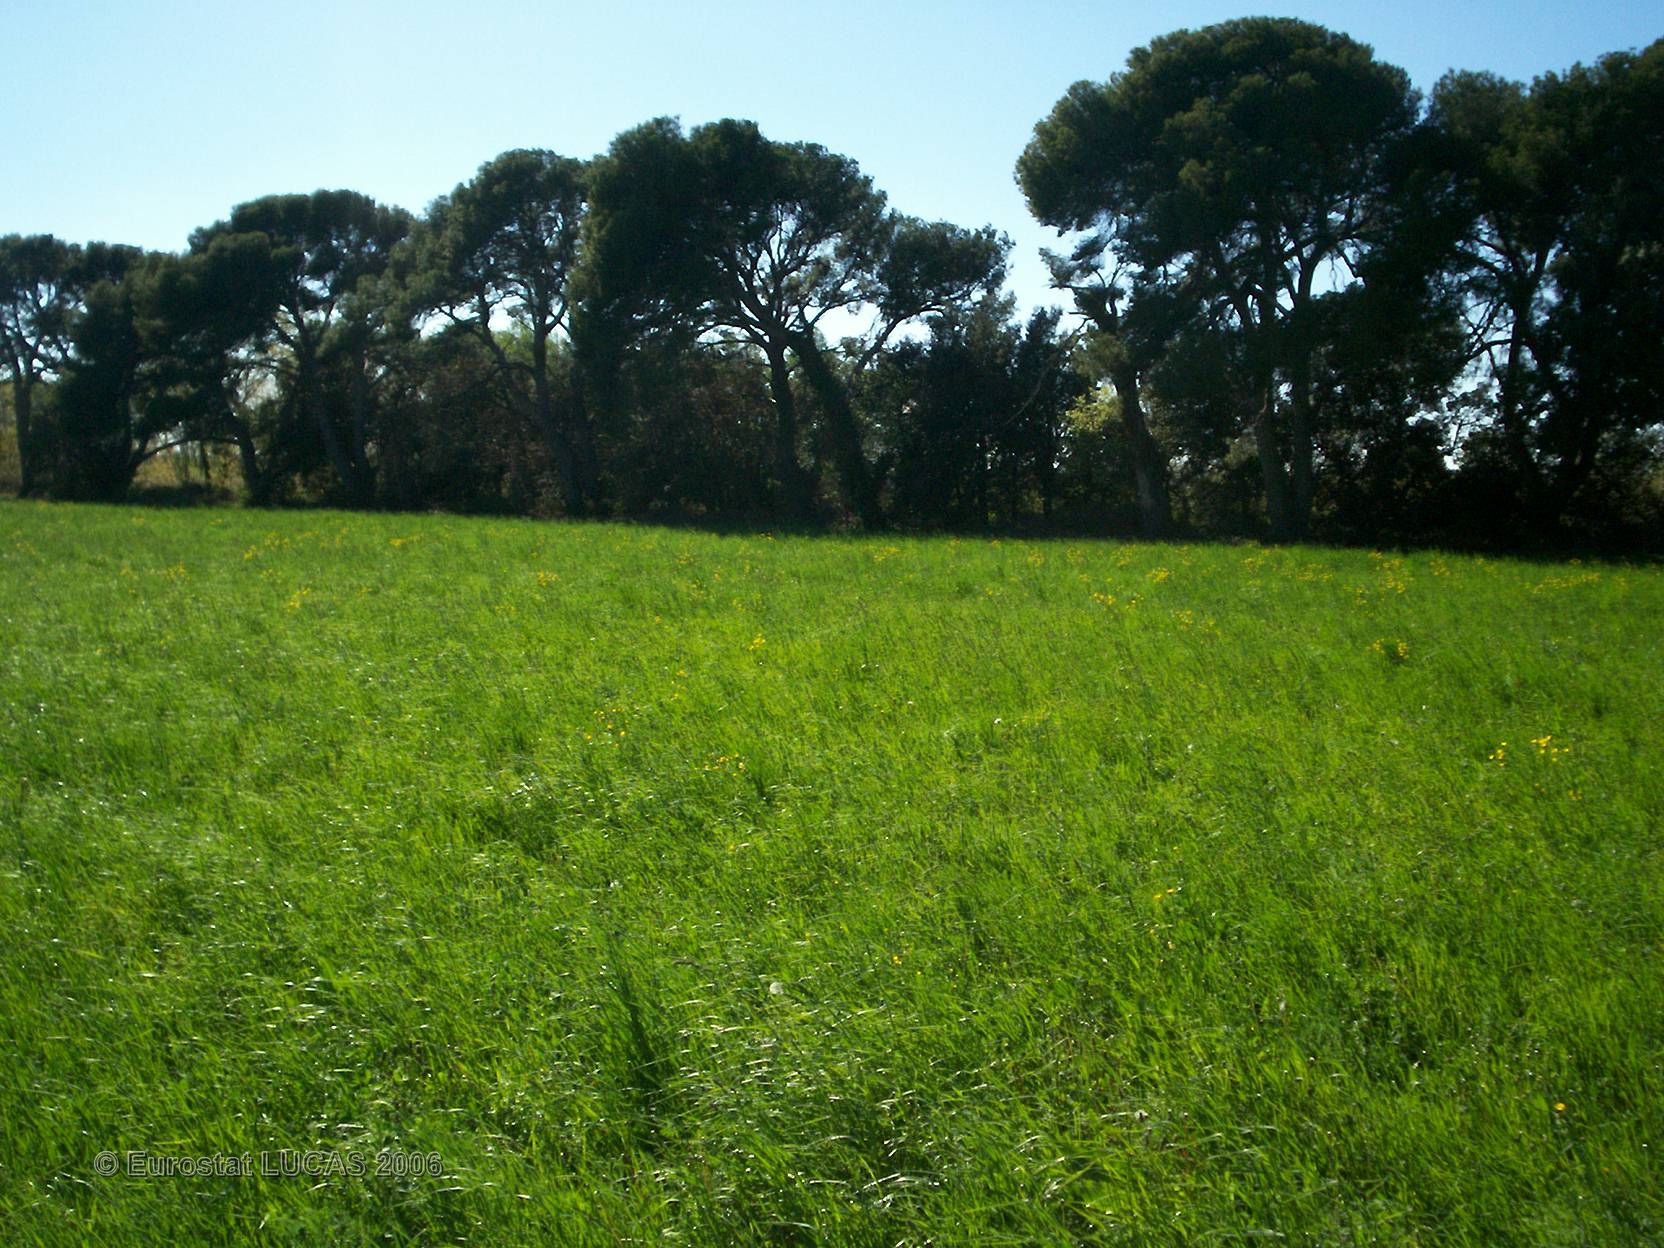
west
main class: Grassland
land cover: Grassland without tree/shrub cover
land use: Agriculture (excluding fallow land and kitchen gardens)
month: April
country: FR
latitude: 43.5600
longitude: 4.9712
